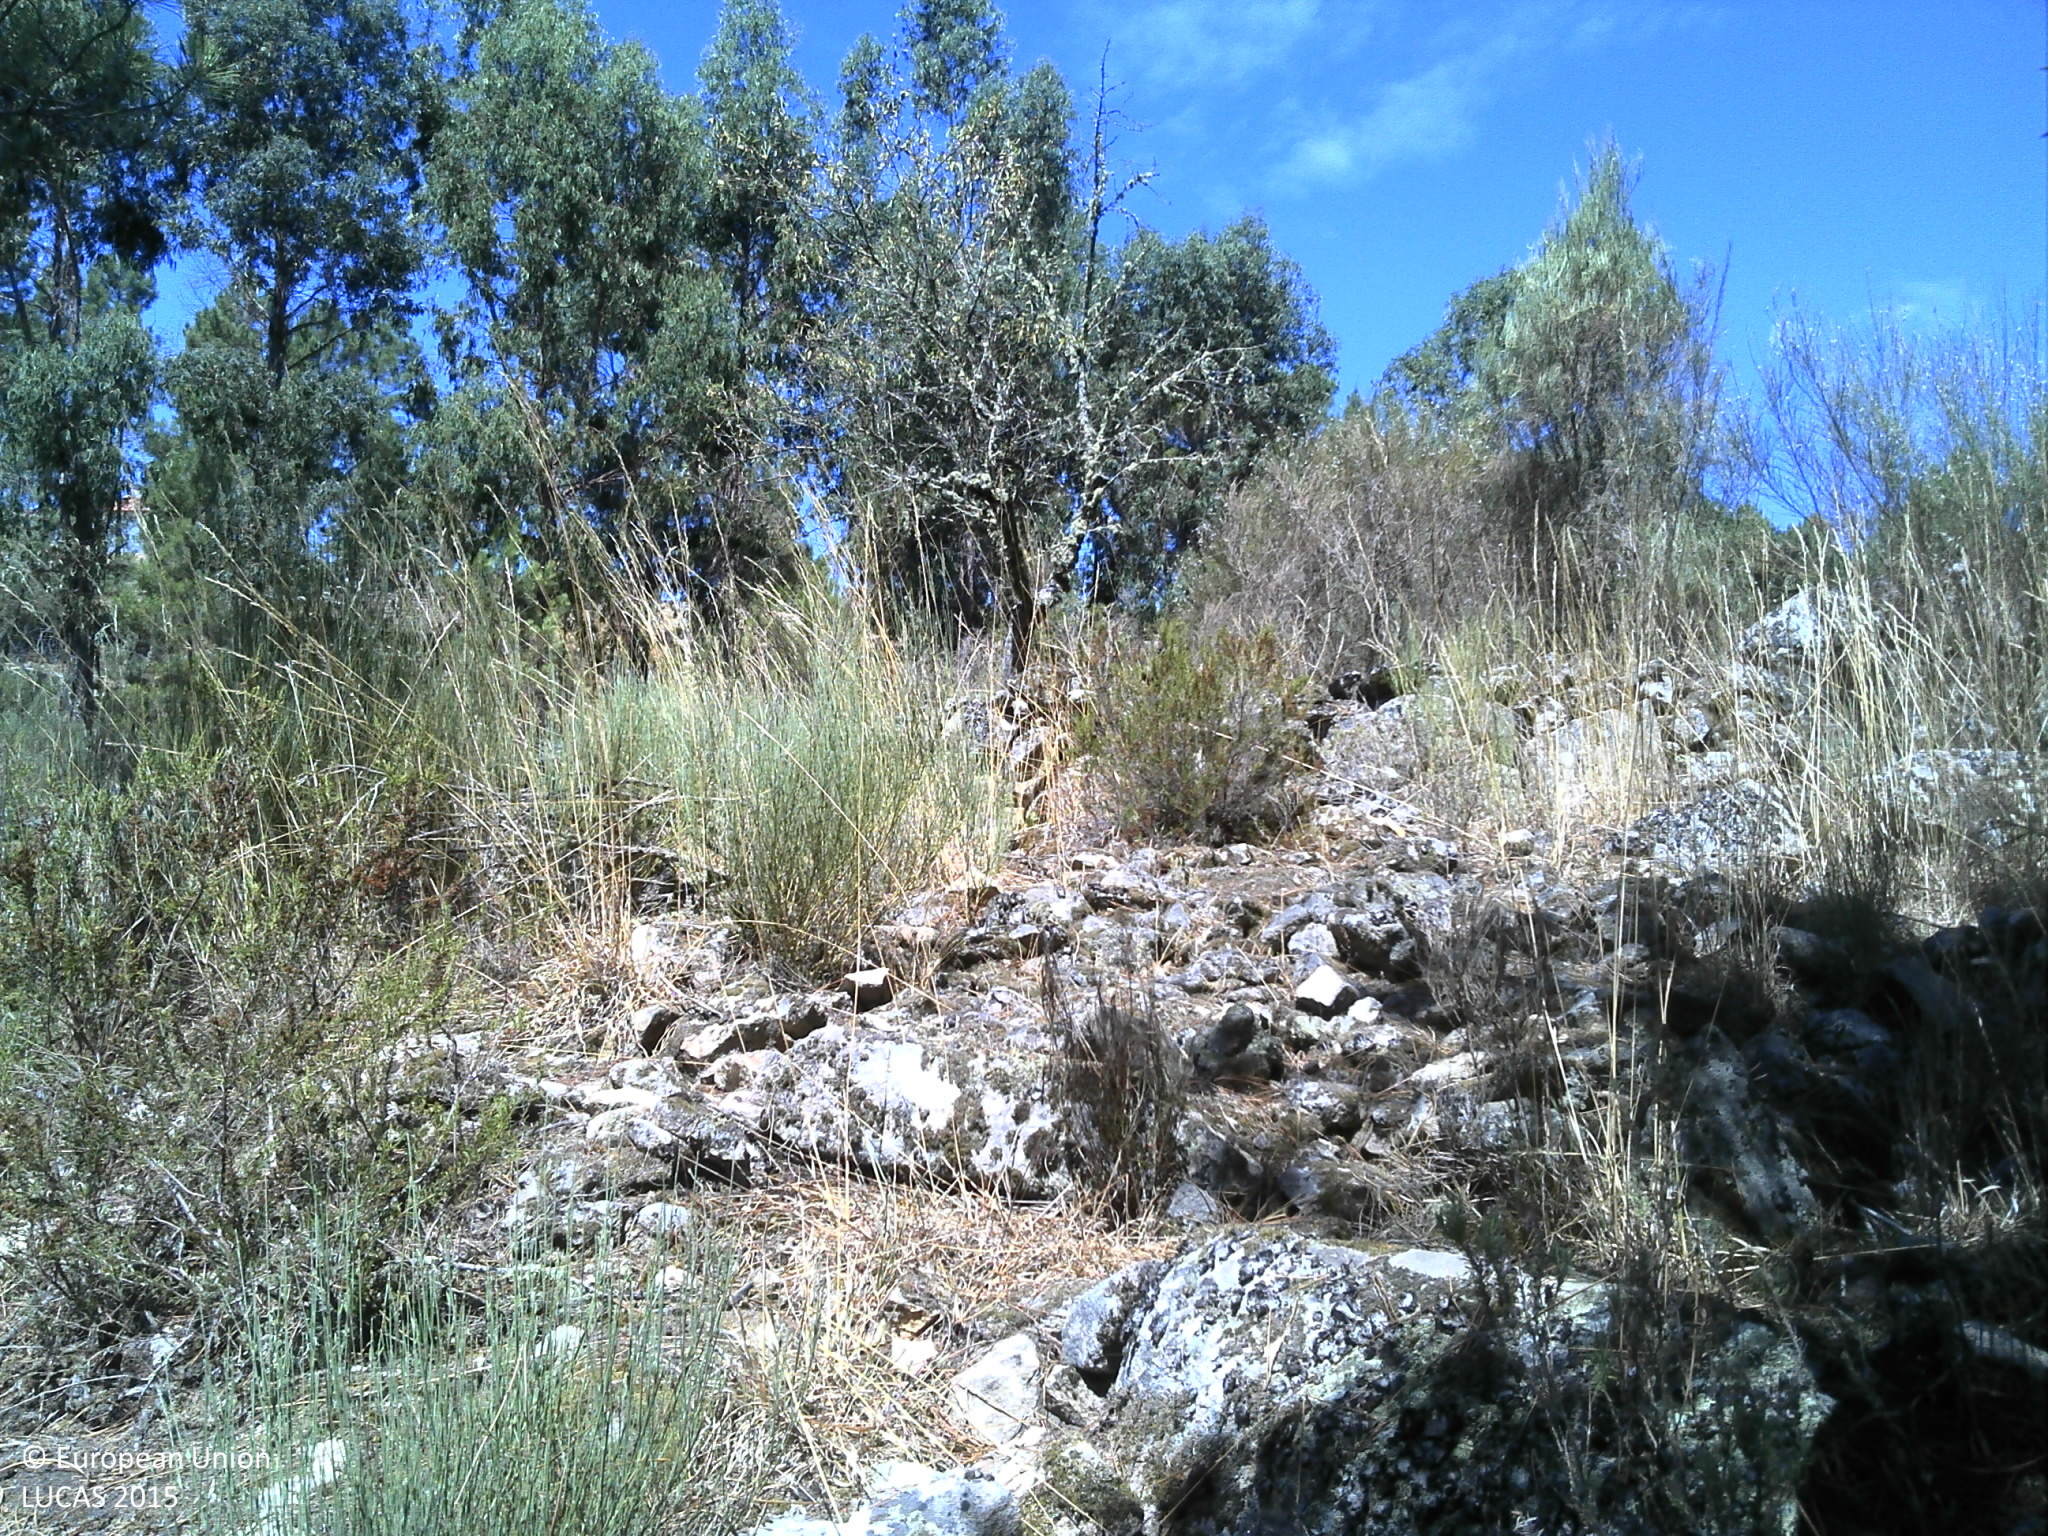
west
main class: Woodland
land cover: Pine dominated coniferous woodland
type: coniferous forest of the mediterranean region
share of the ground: < 10 %
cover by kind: unconsolidated bare surface 80 %, coniferous forest trees 15 %, shrubs 5 %
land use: Forestry
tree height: > 5 m
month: July
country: PT
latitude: 41.3666
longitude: -7.5447
